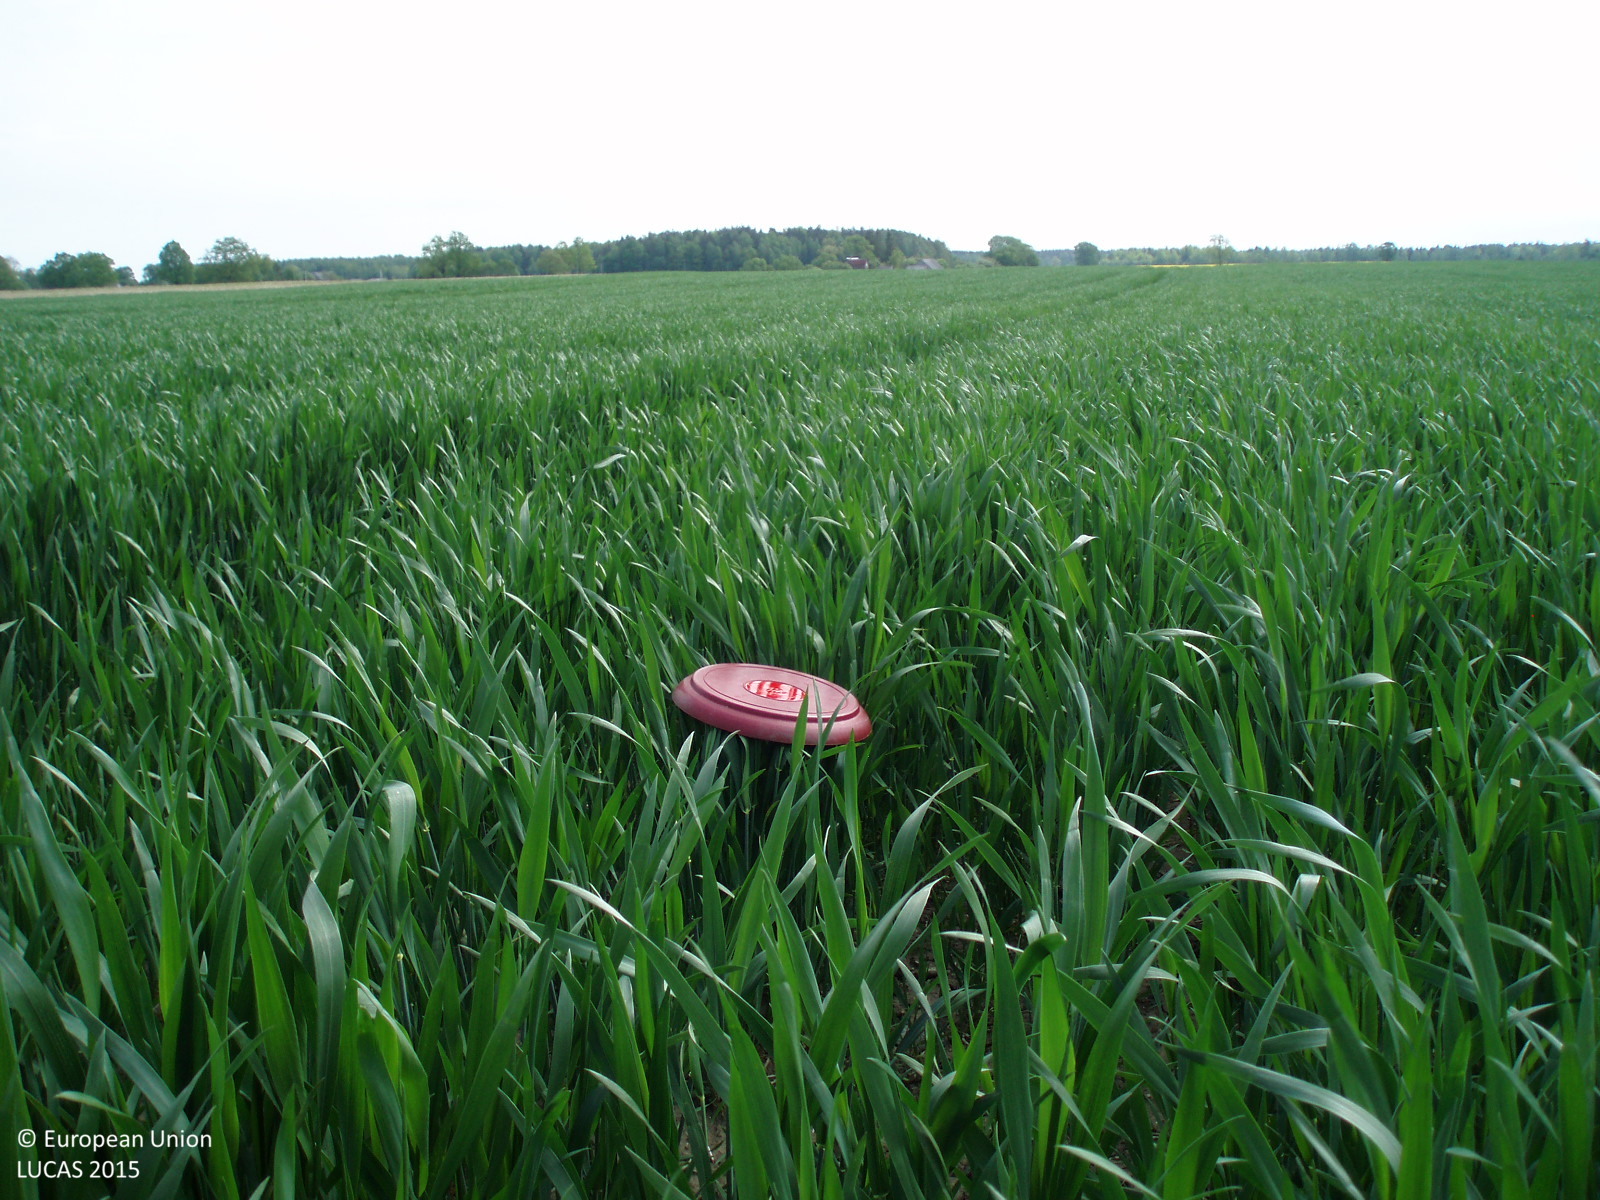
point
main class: Cropland
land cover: Common wheat
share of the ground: > 75 %
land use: Agriculture (excluding fallow land and kitchen gardens)
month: May
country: LT
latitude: 56.1831
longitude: 22.4143
